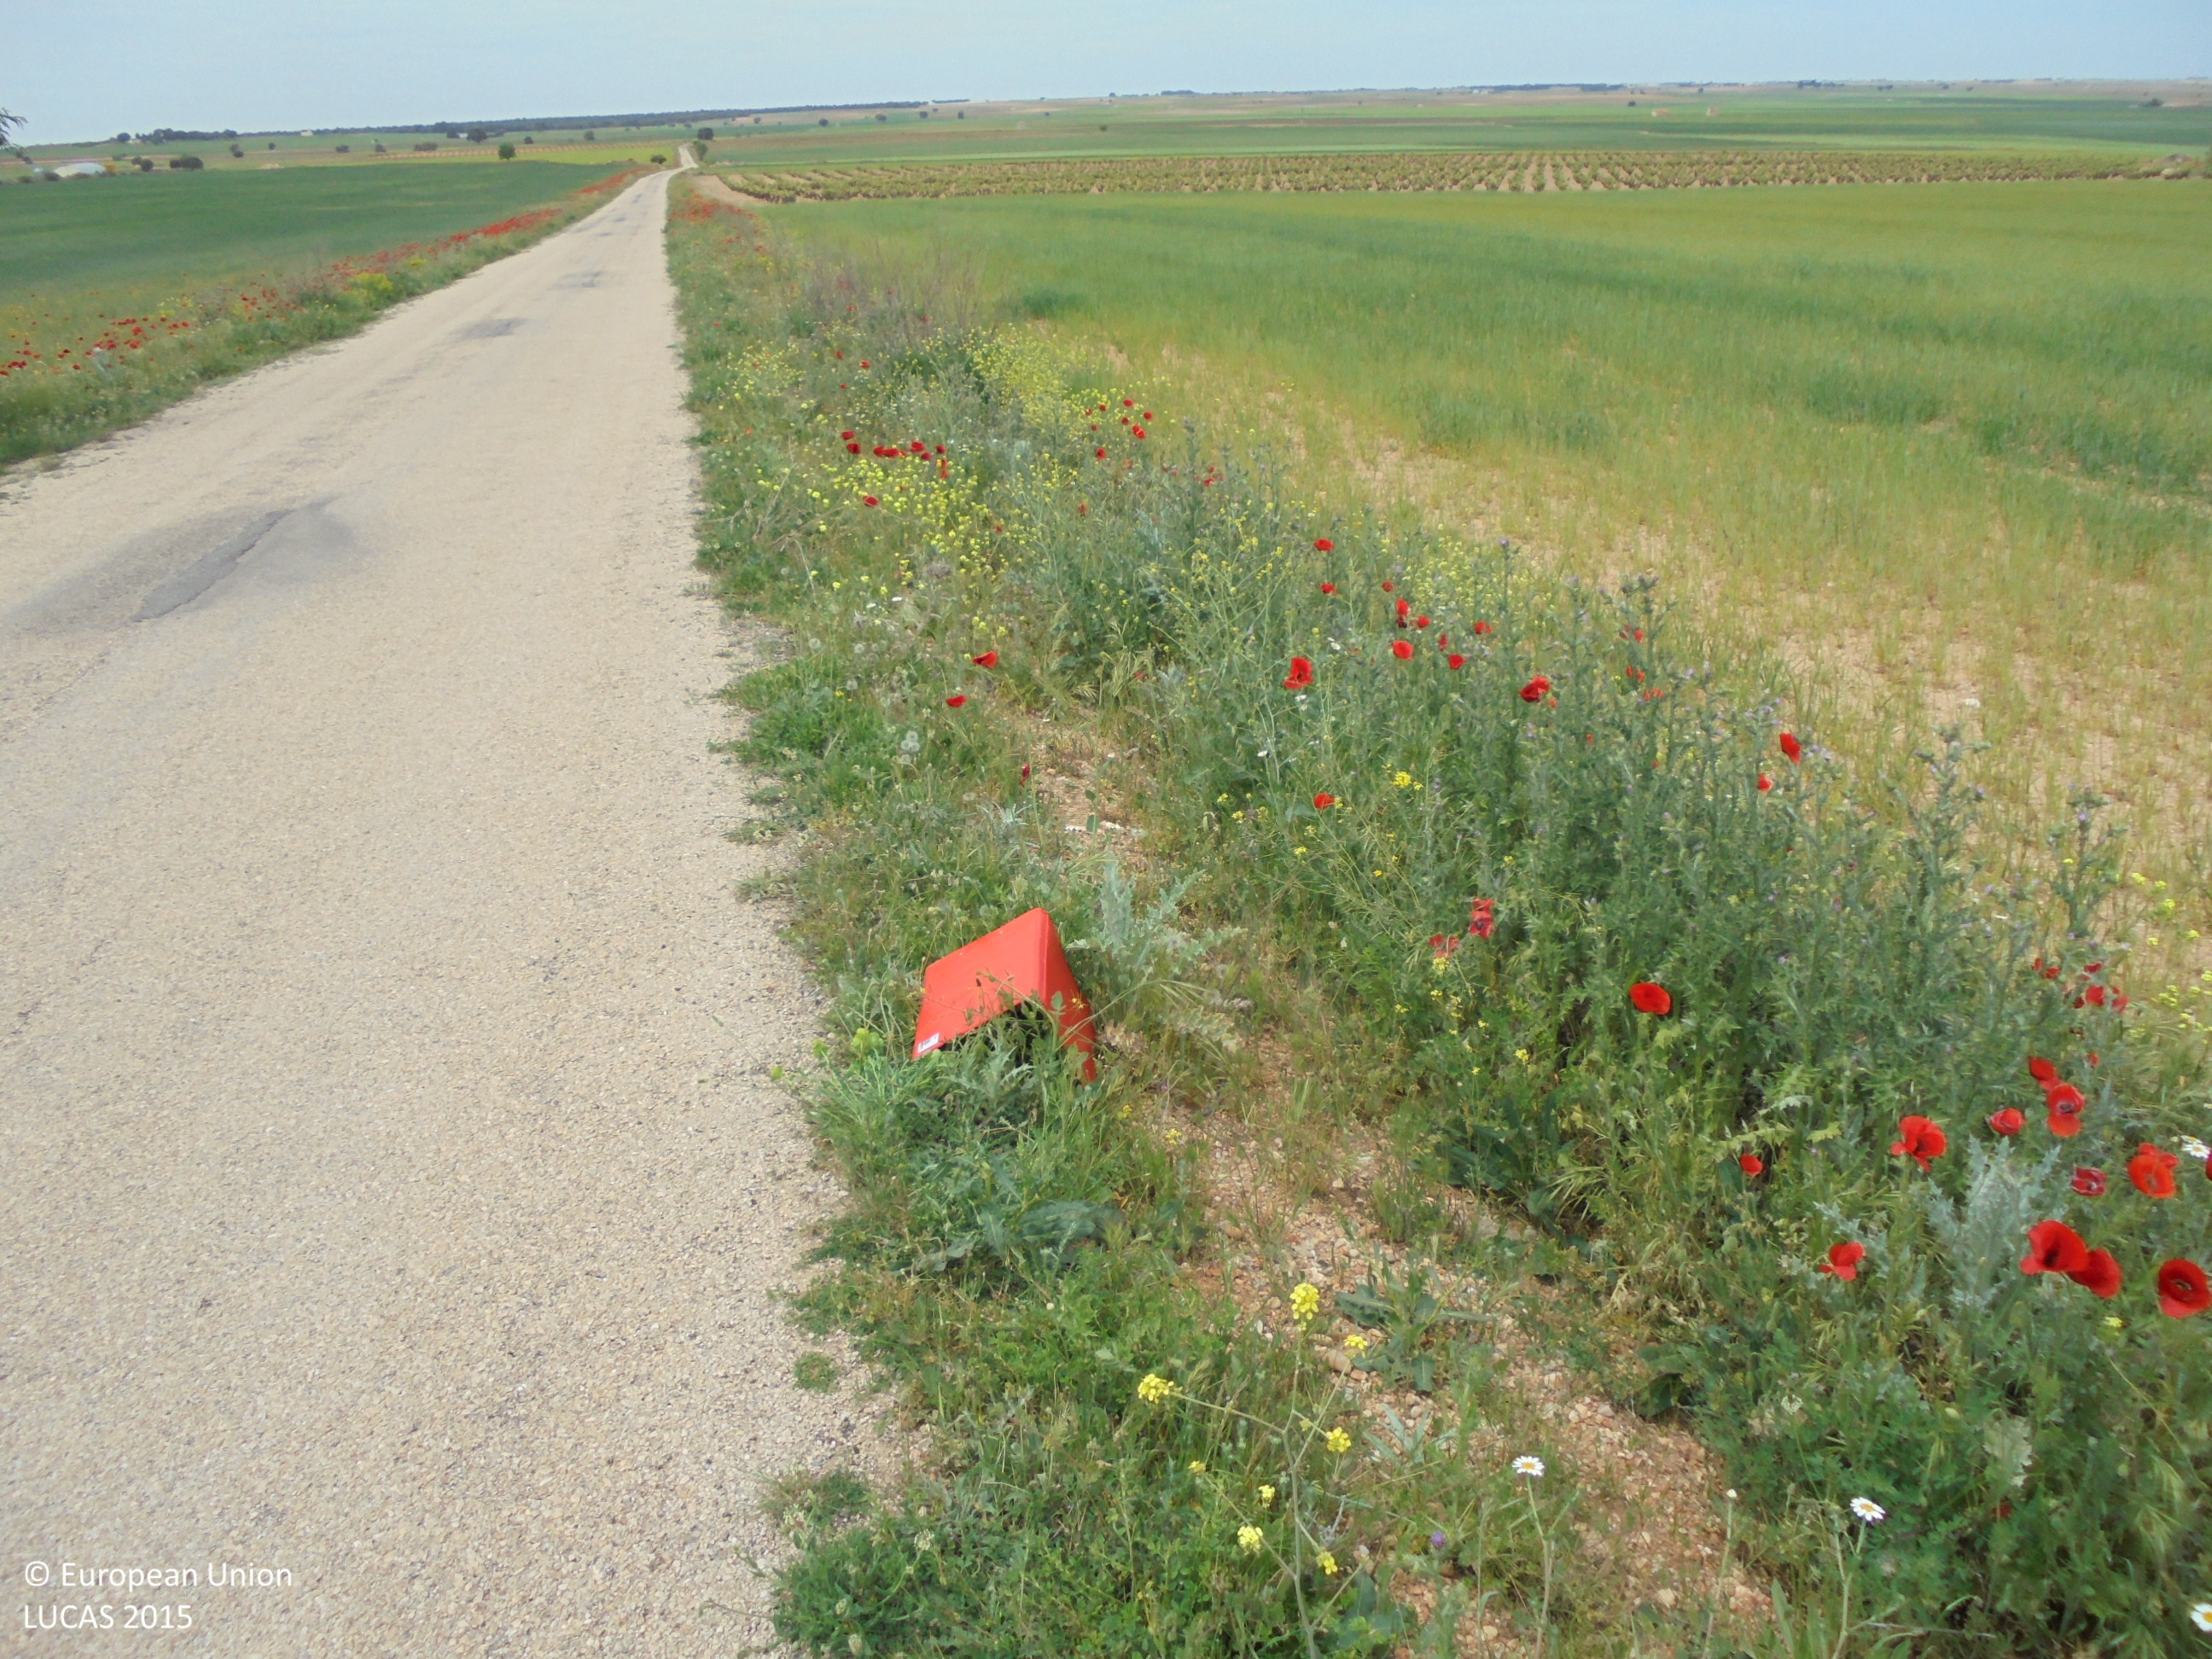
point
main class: Cropland
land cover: Barley
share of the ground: 25 - 50 %
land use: Agriculture (excluding fallow land and kitchen gardens)
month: May
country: ES
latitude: 39.2424
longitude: -1.6462
